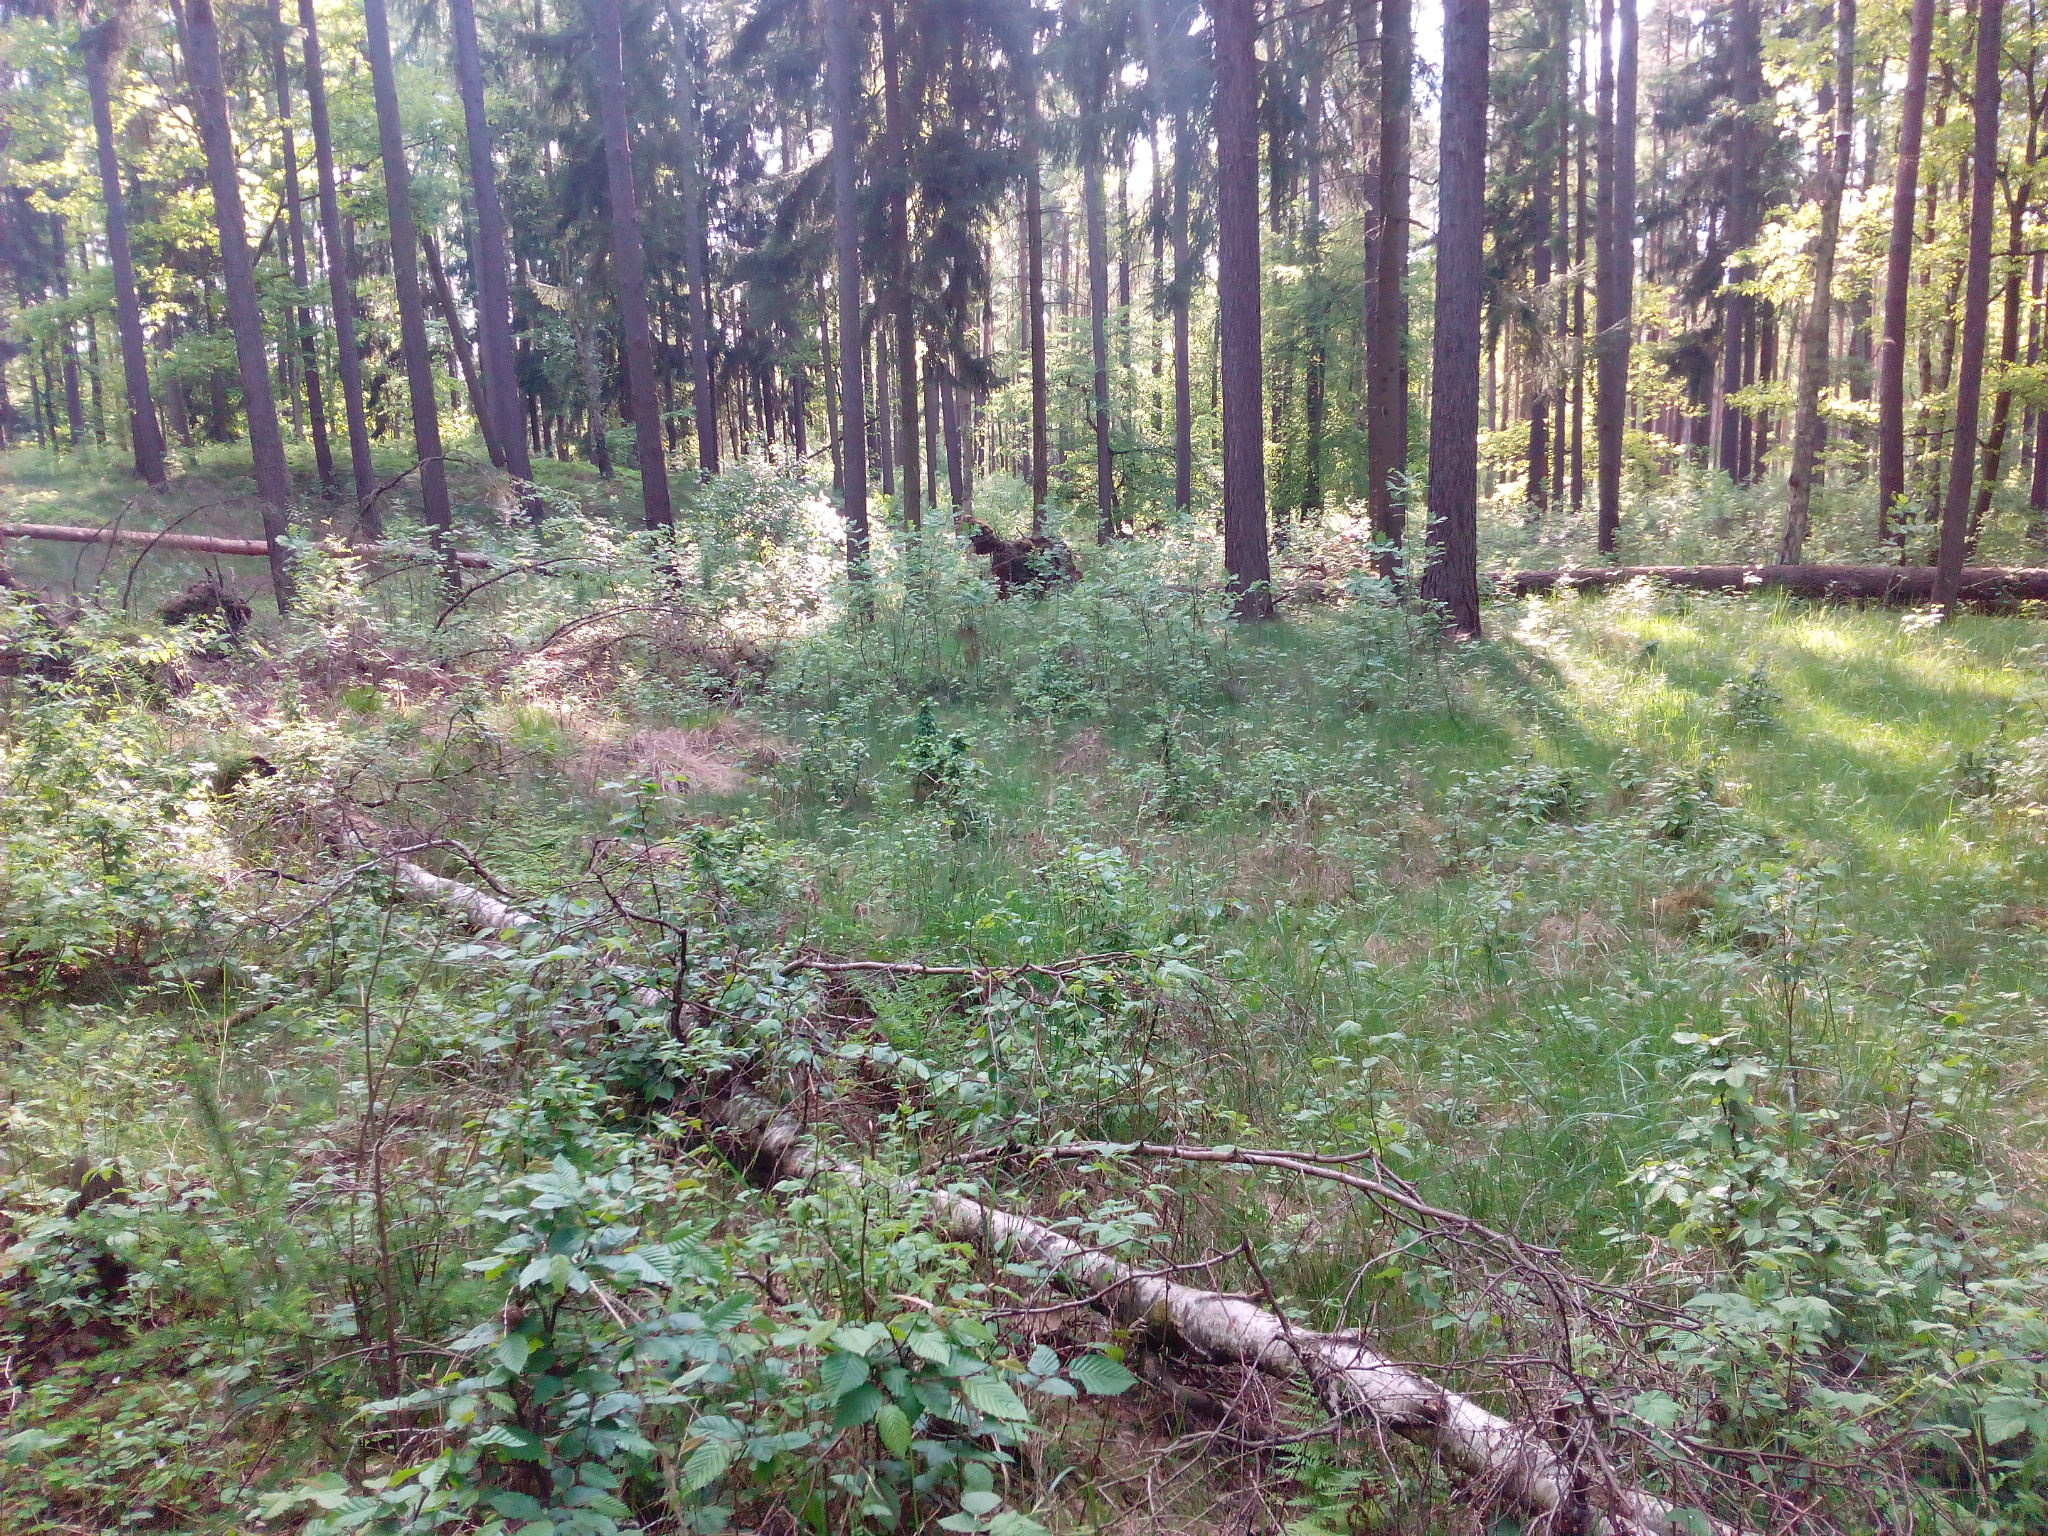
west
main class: Woodland
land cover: Other mixed woodland
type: hemiboreal forest and nemoral coniferous forest and mixed broadleaved-coniferous forest
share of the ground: 25 - 50 %
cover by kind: coniferous forest trees 30 %, broadleaved forest trees 25 %, herbaceous plants 25 %, lichens and mosses 20 %
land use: Forestry
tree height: > 5 m
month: May
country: DE
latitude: 52.9360
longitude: 13.5561
